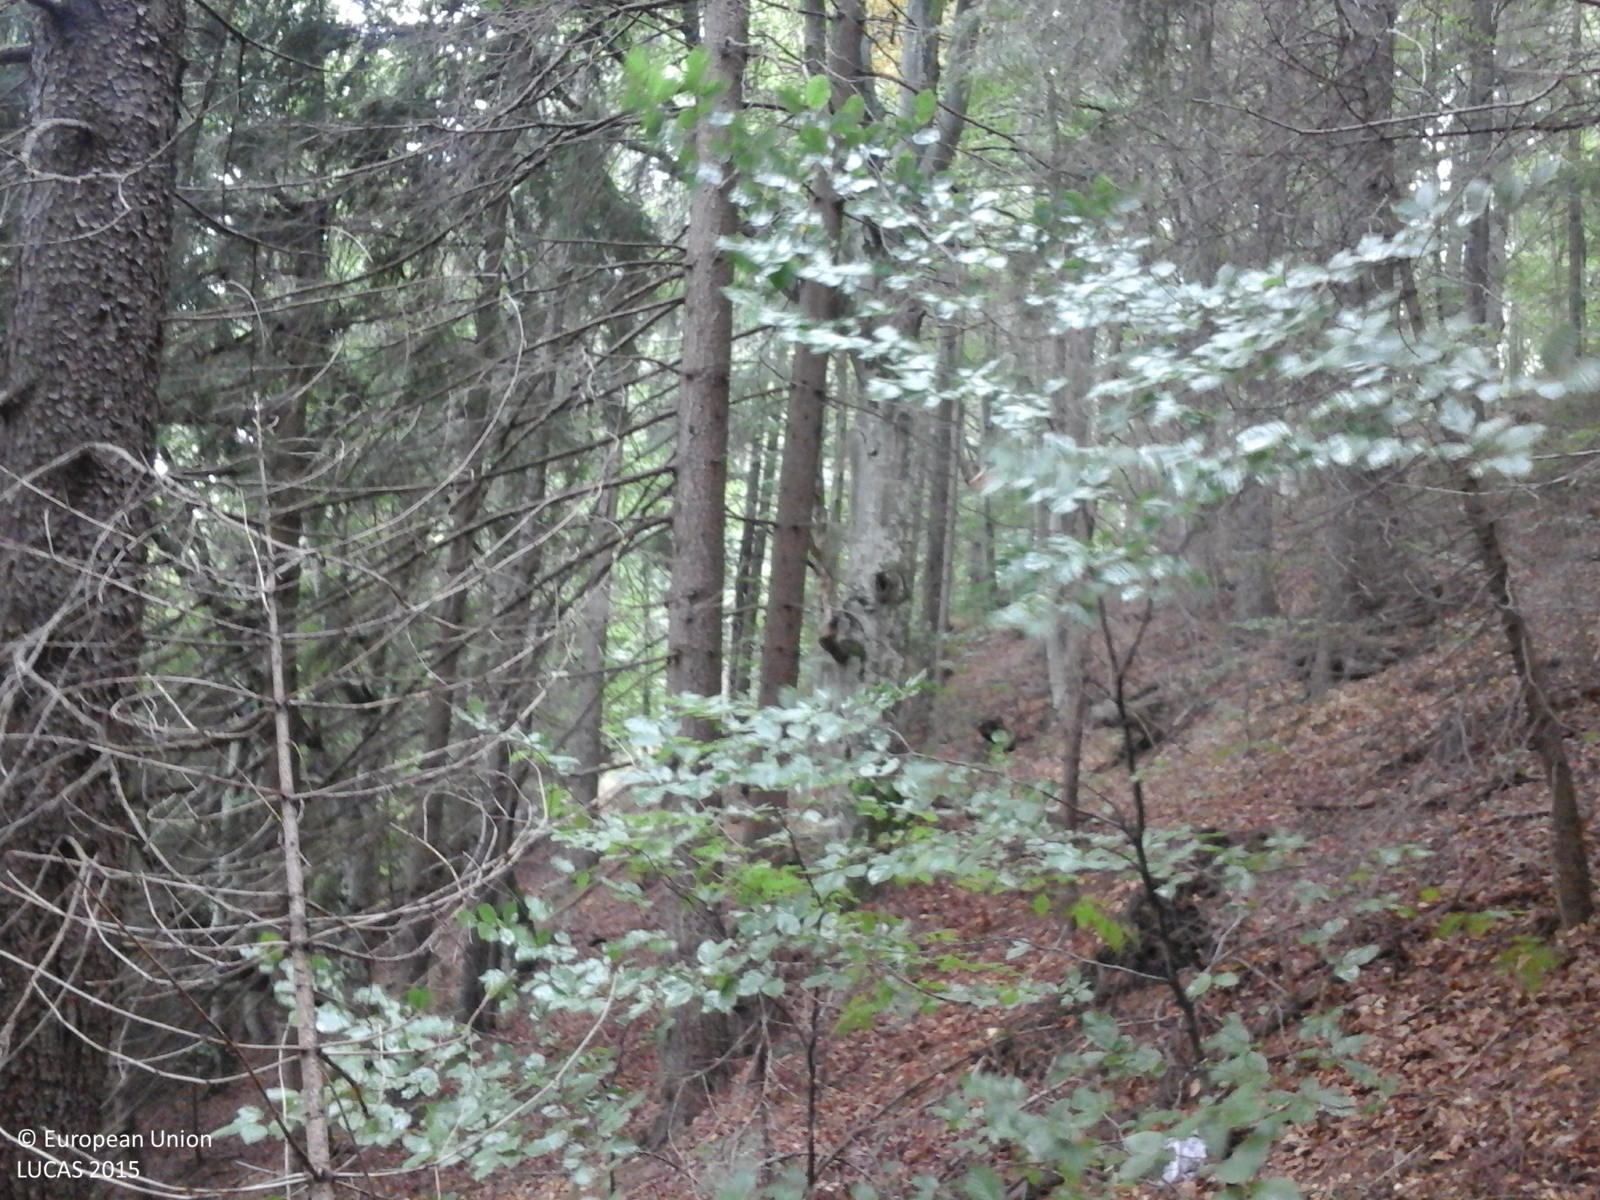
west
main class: Woodland
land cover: Spruce dominated mixed woodland
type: alpine coniferous forest
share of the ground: > 75 %
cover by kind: coniferous forest trees 70 %, broadleaved forest trees 30 %
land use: Forestry
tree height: > 5 m
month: September
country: RO
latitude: 47.6672
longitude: 23.8923
